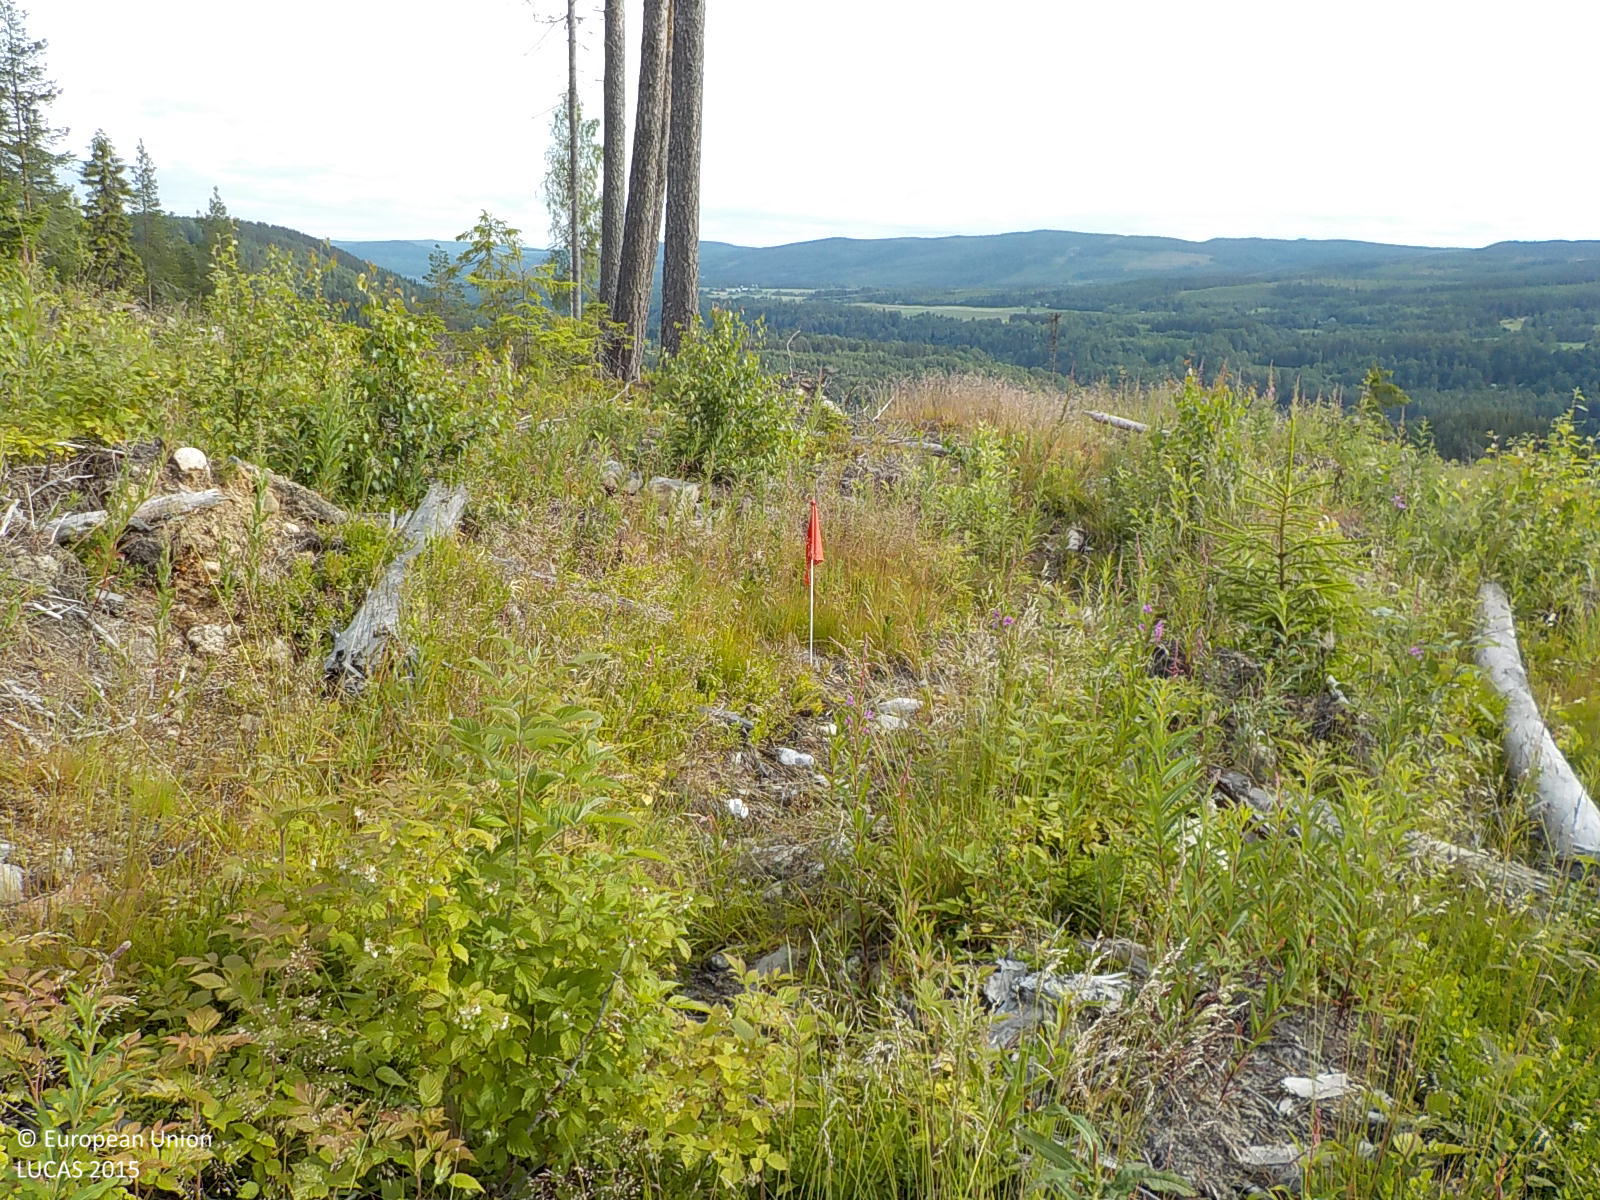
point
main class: Woodland
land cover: Other mixed woodland
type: boreal forest
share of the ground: 25 - 50 %
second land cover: Grassland without tree/shrub cover
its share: 25 - 50 %
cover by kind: herbaceous plants 35 %, coniferous forest trees 30 %, broadleaved forest trees 30 %, shrubs 5 %
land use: Forestry
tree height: < 5 m
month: July
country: SE
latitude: 63.2015
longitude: 17.1923
